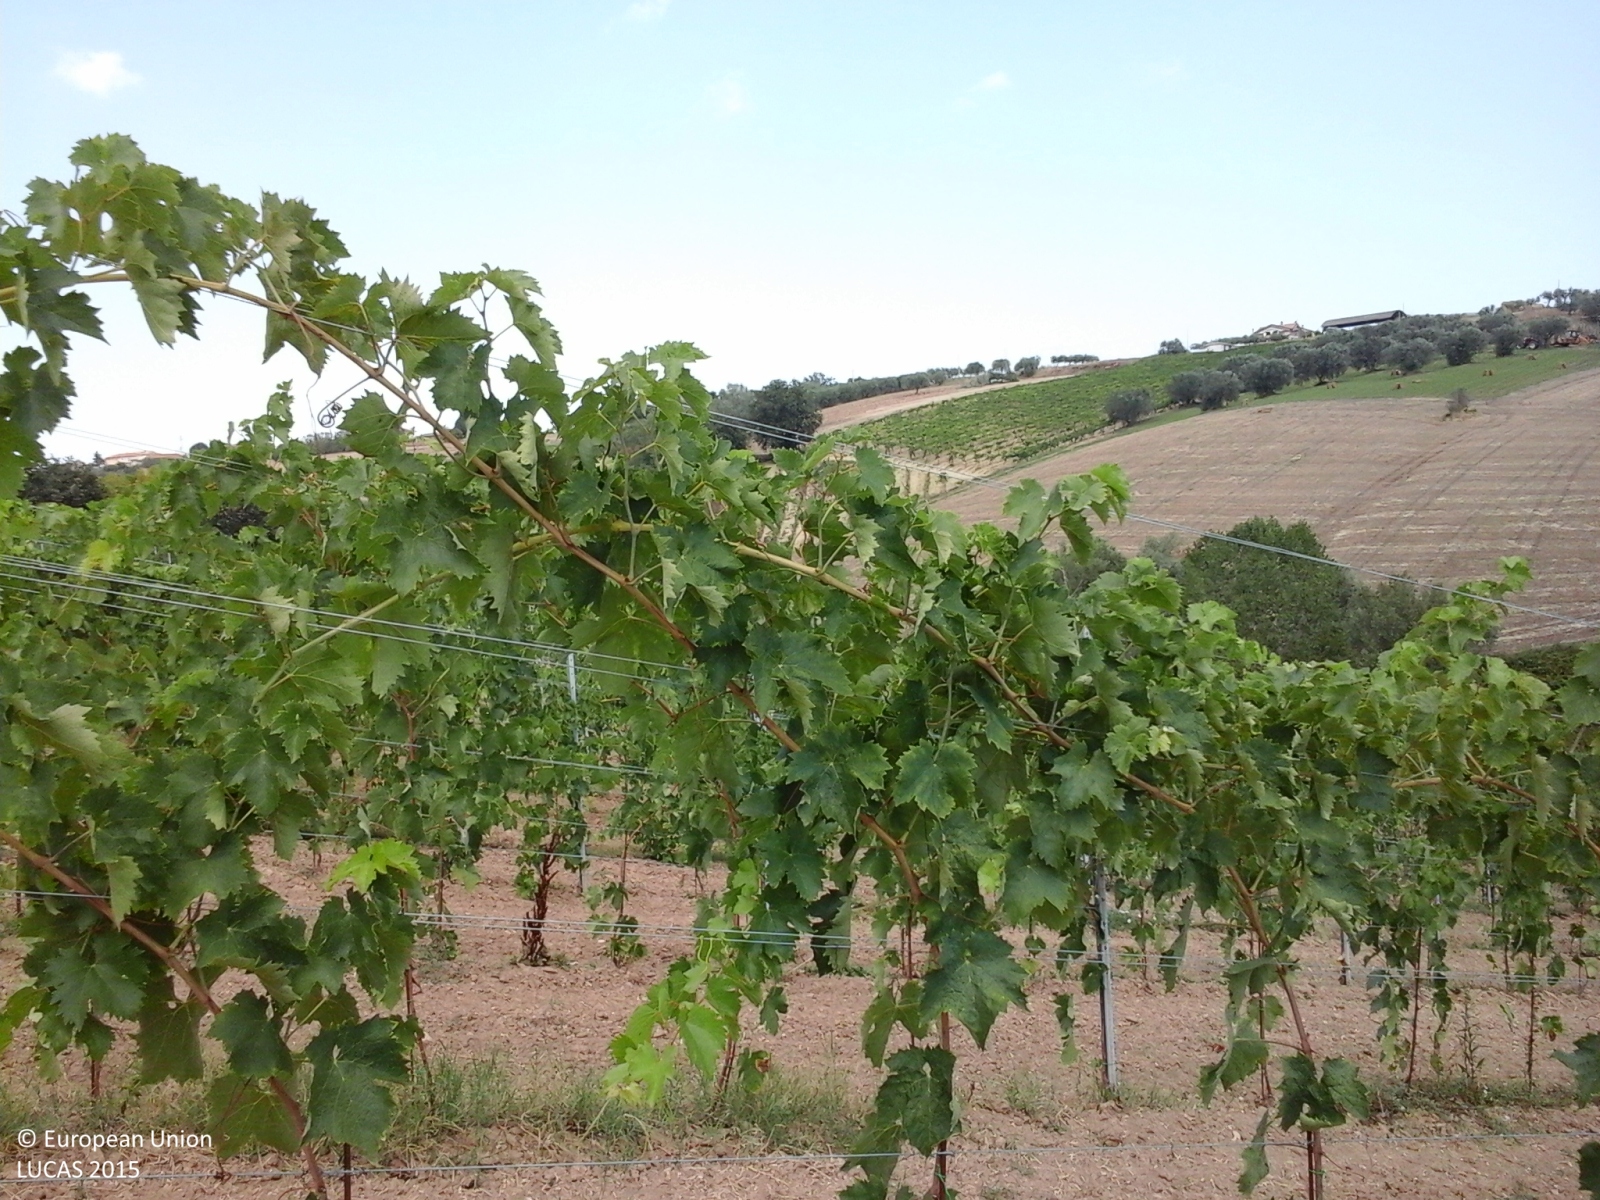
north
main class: Cropland
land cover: Vineyards
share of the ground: 25 - 50 %
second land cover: Spontaneously vegetated surfaces
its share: 25 - 50 %
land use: Agriculture (excluding fallow land and kitchen gardens)
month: August
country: IT
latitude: 42.6682
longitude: 13.9297
